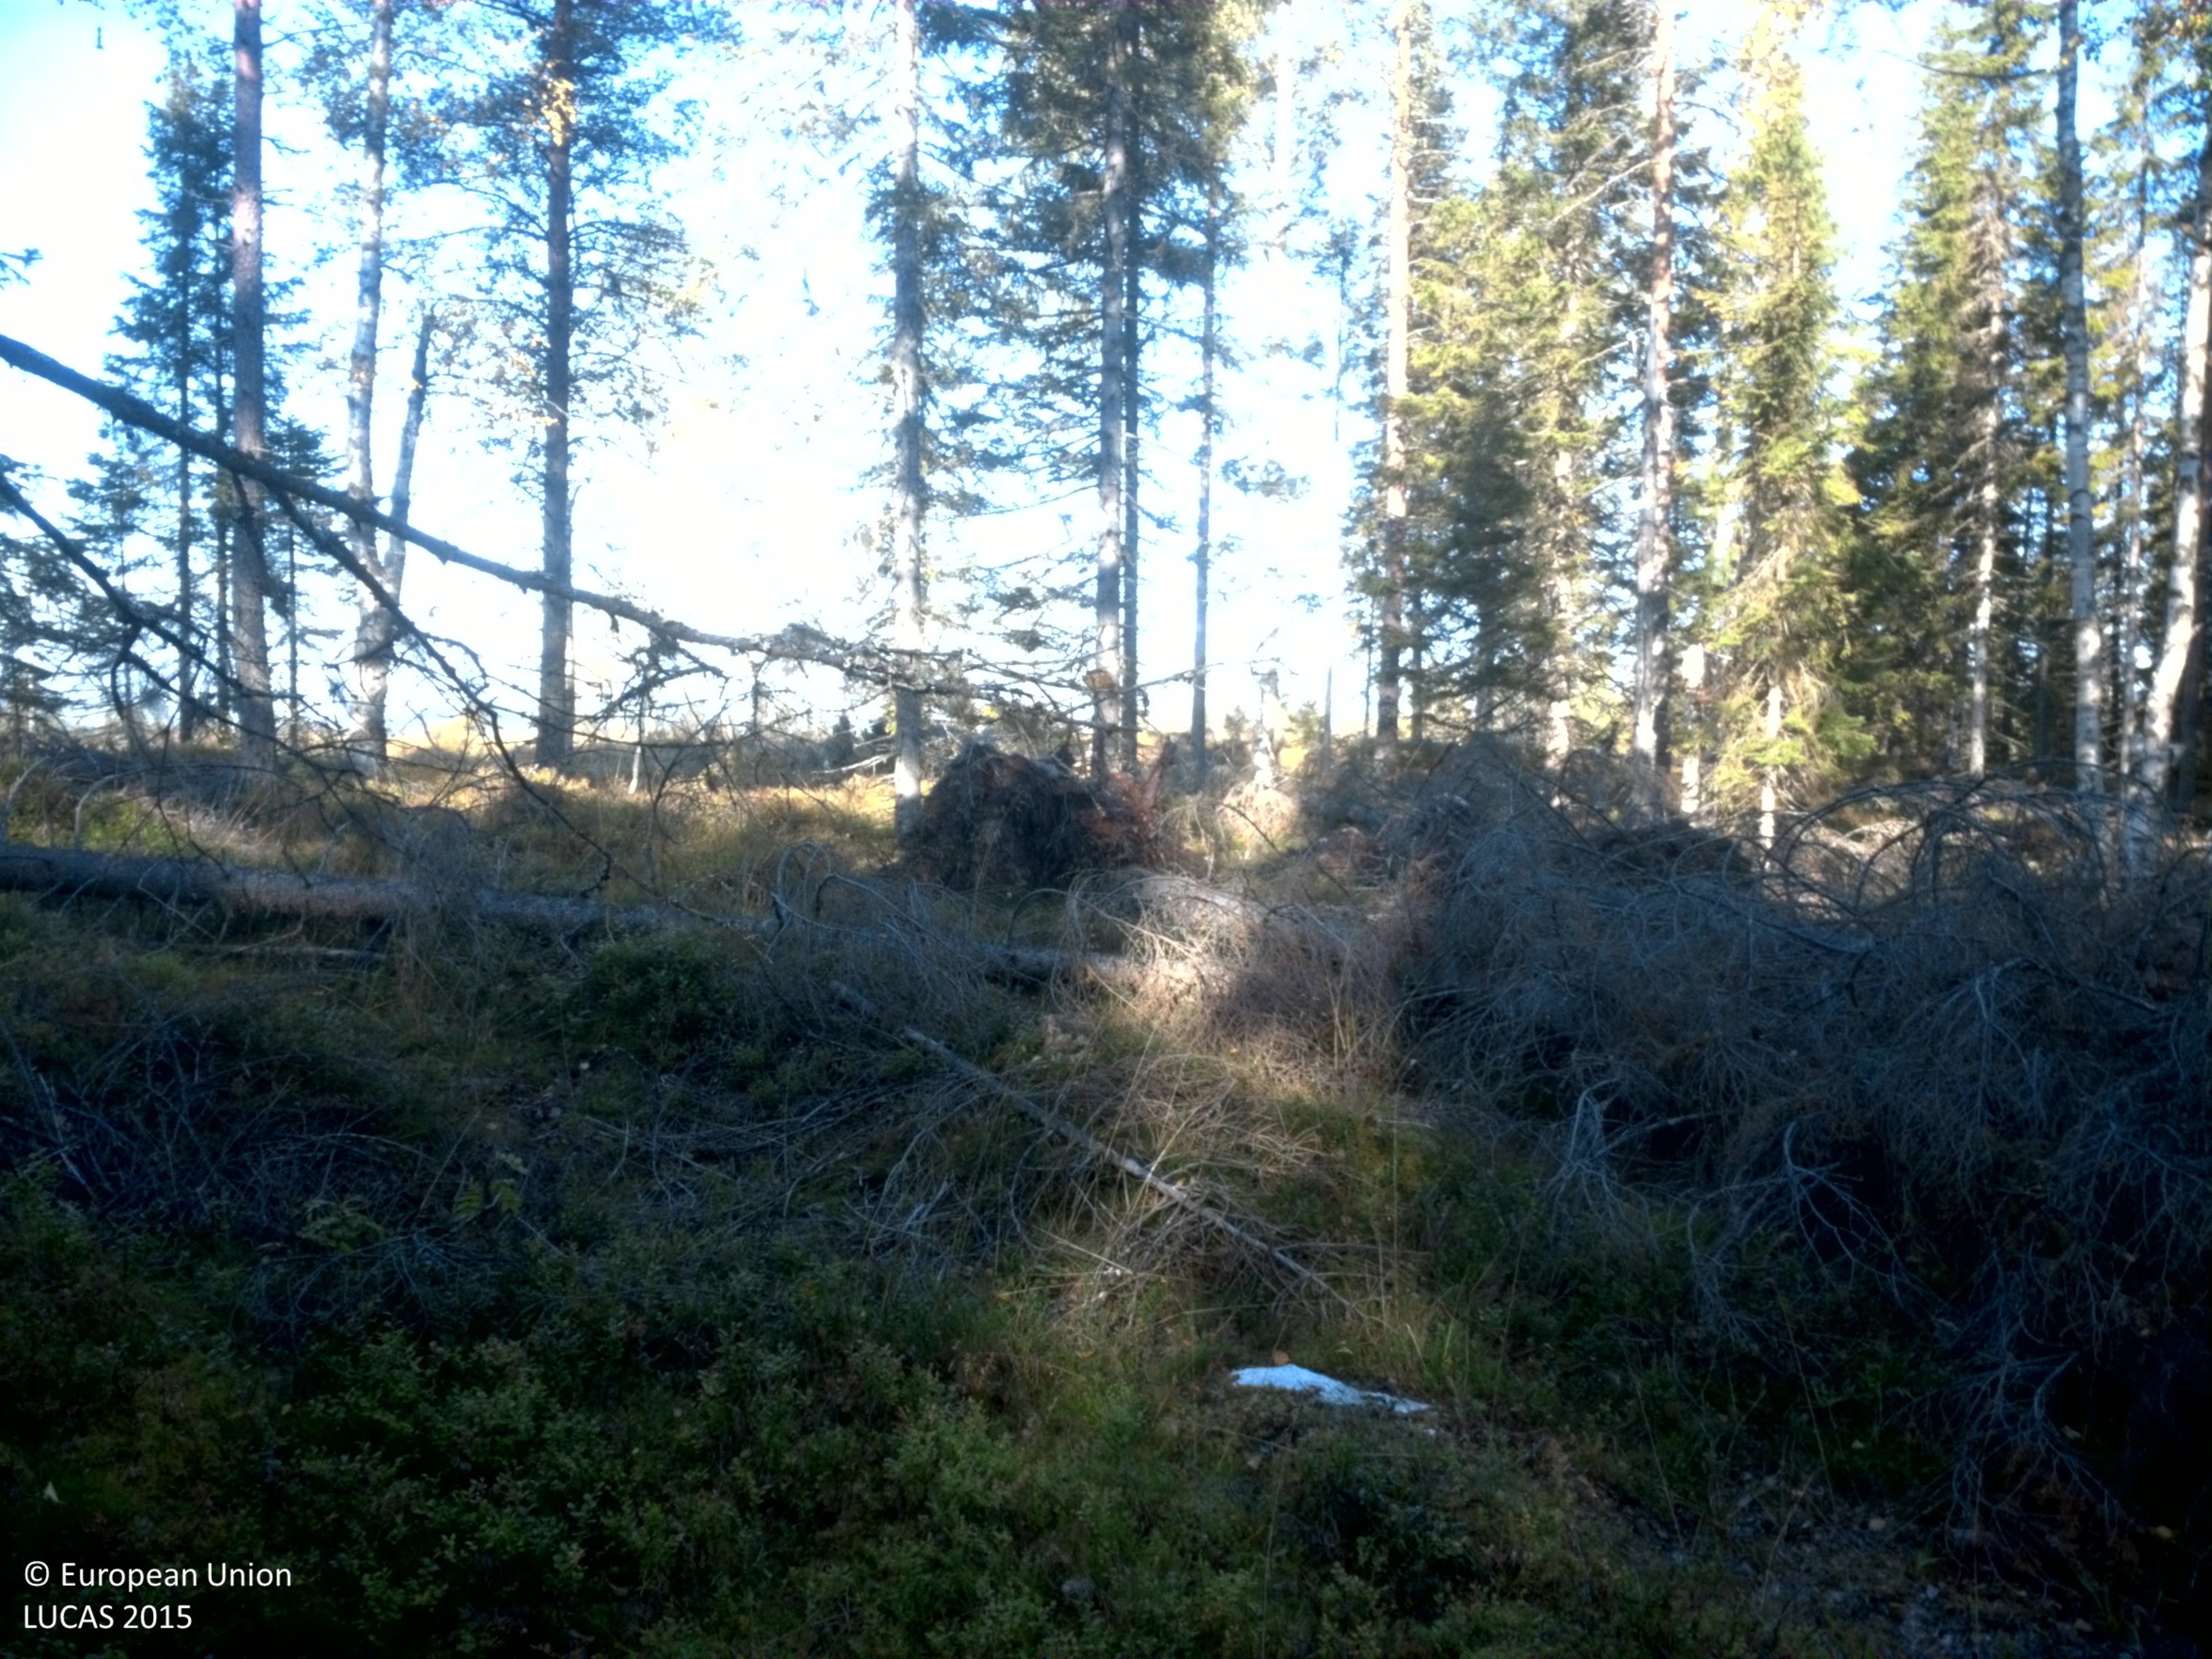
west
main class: Woodland
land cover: Spruce dominated coniferous woodland
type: boreal forest
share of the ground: 50 - 75 %
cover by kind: coniferous forest trees 50 %, shrubs 45 %, broadleaved forest trees 5 %
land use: Forestry
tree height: > 5 m
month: September
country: SE
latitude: 64.3745
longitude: 19.9846
